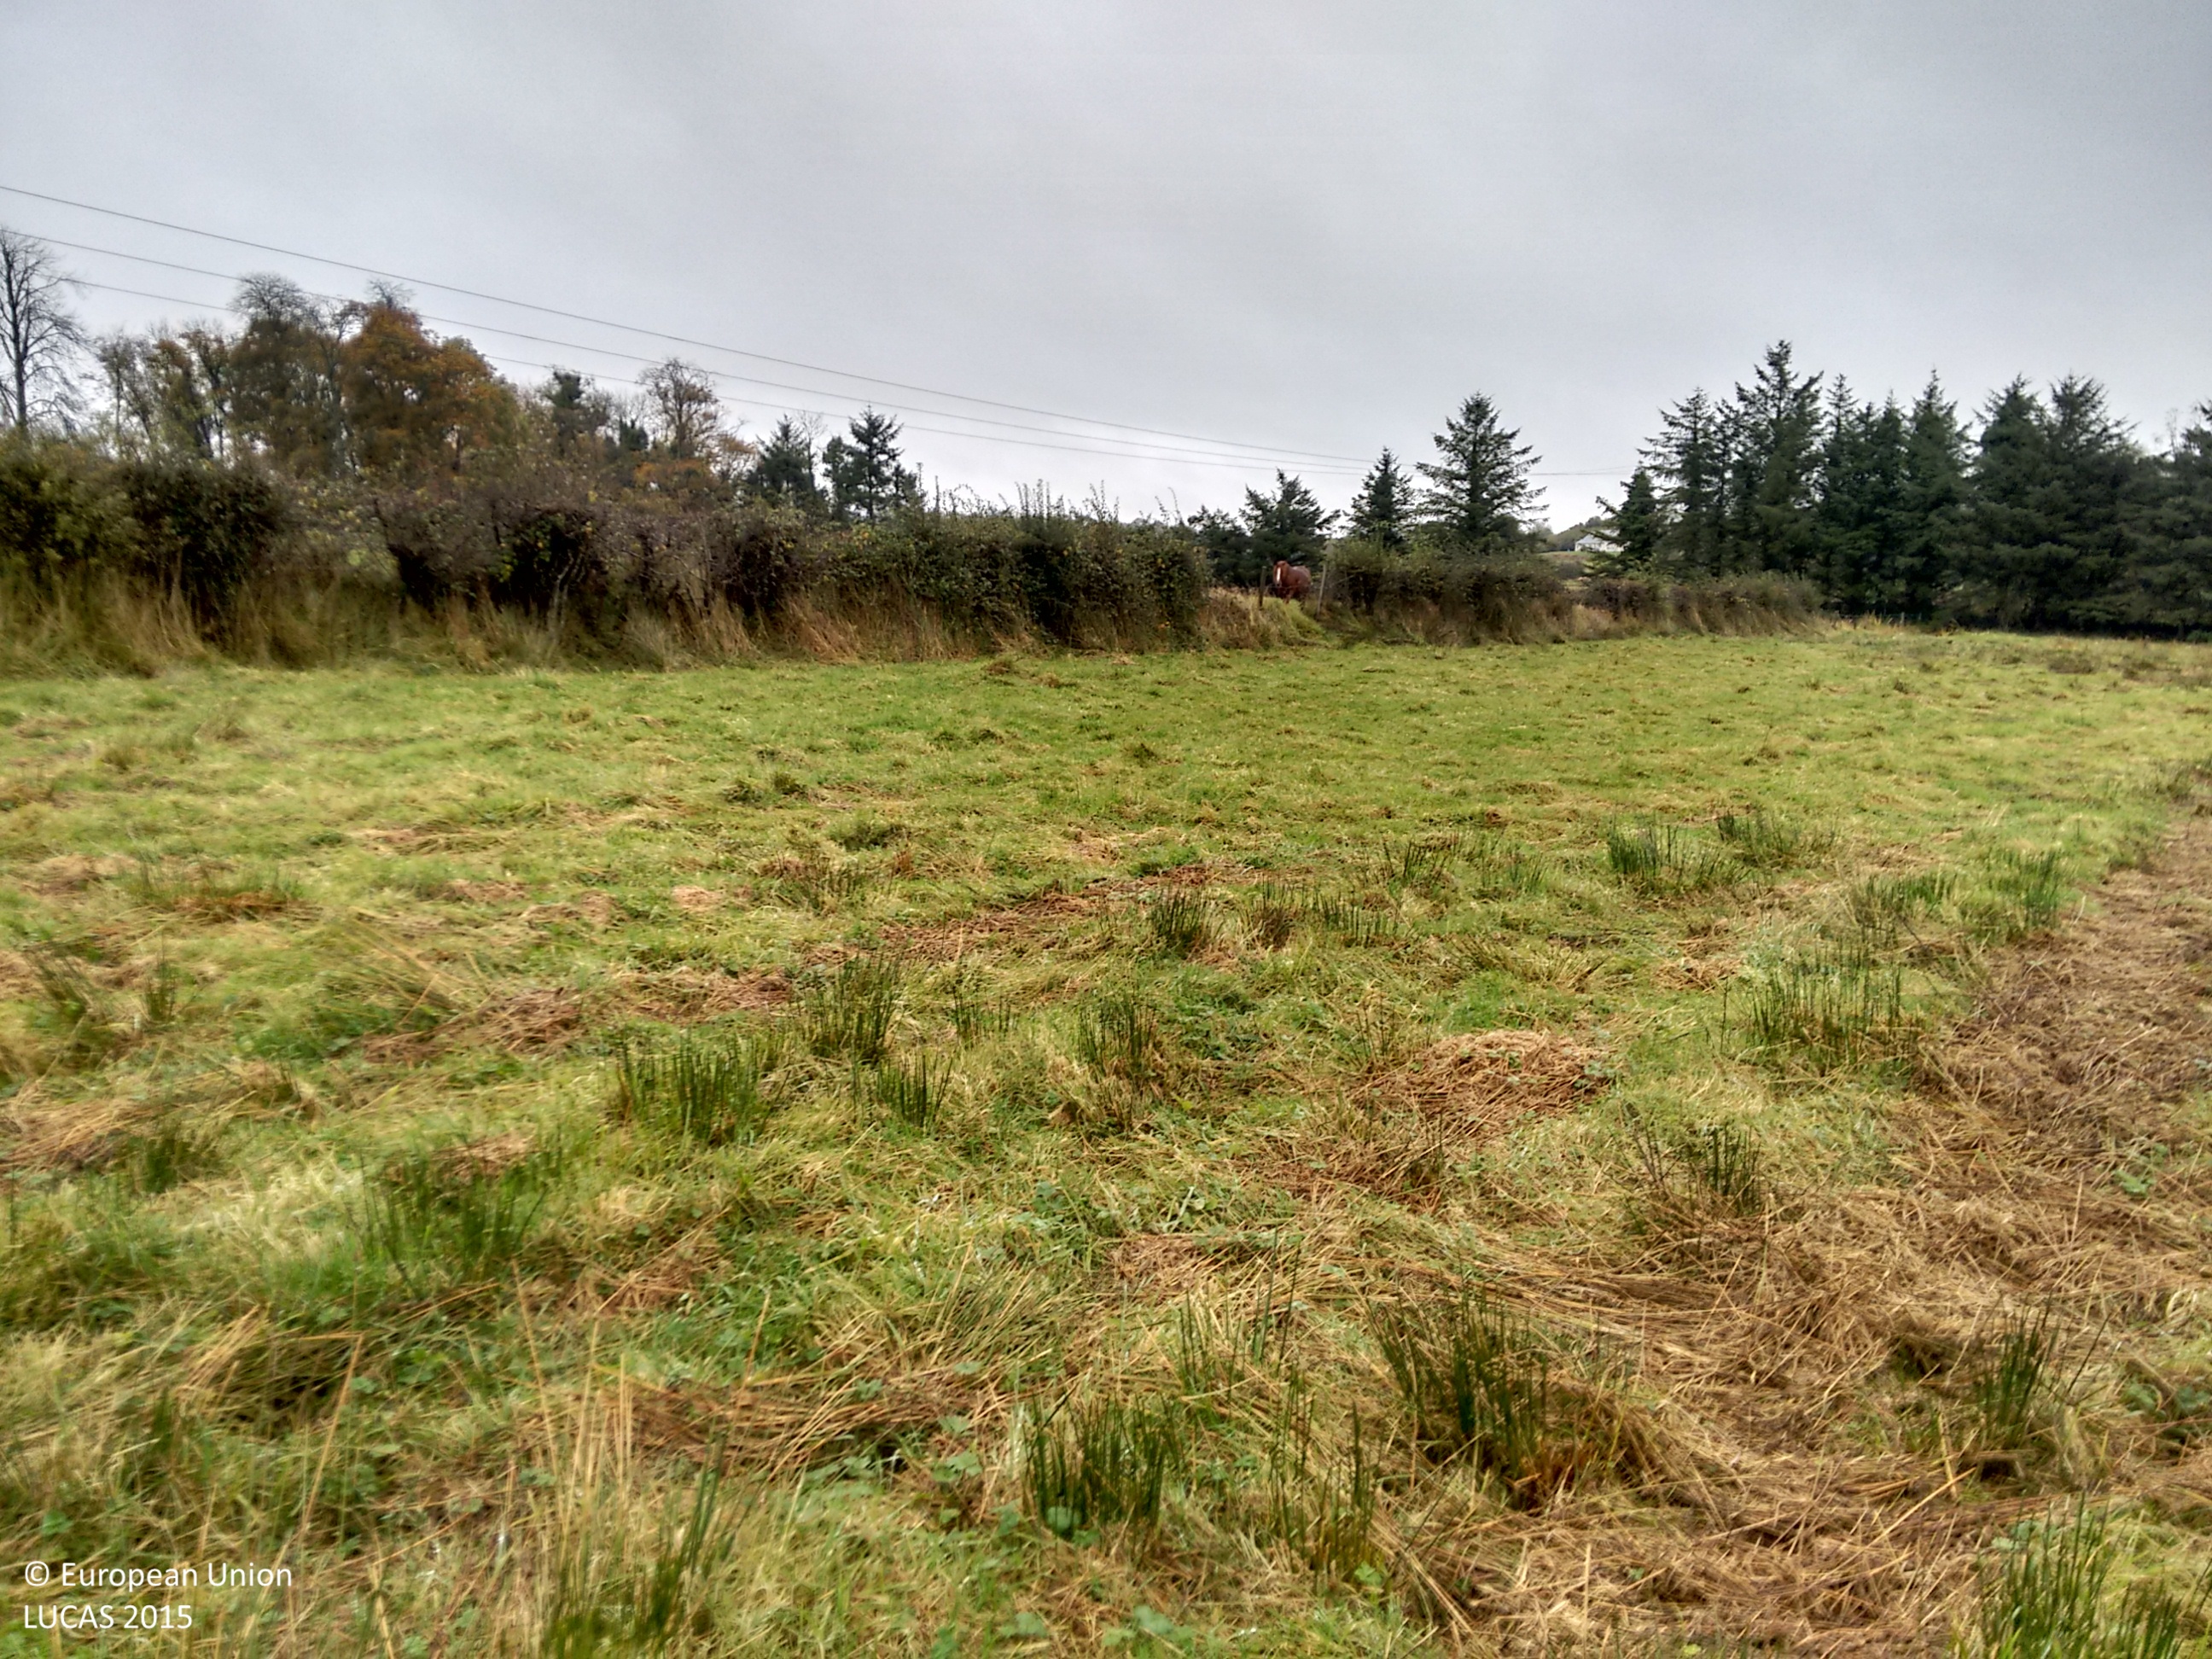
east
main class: Grassland
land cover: Grassland without tree/shrub cover
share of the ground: > 75 %
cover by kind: herbaceous plants 100 %
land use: Agriculture (excluding fallow land and kitchen gardens)
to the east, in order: Grassland without tree/shrub cover; Abandoned hedges; Fences; Abandoned hedges; Ditches and canals; Fences; Grassland without tree/shrub cover; Fences; Abandoned hedges; Grass margins; Paved roads, cycling and walking lanes; Artificial constructions; Grassland without tree/shrub cover; Electric lines; Grassland without tree/shrub cover
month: October
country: IE
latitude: 53.8967
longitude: -8.0260
